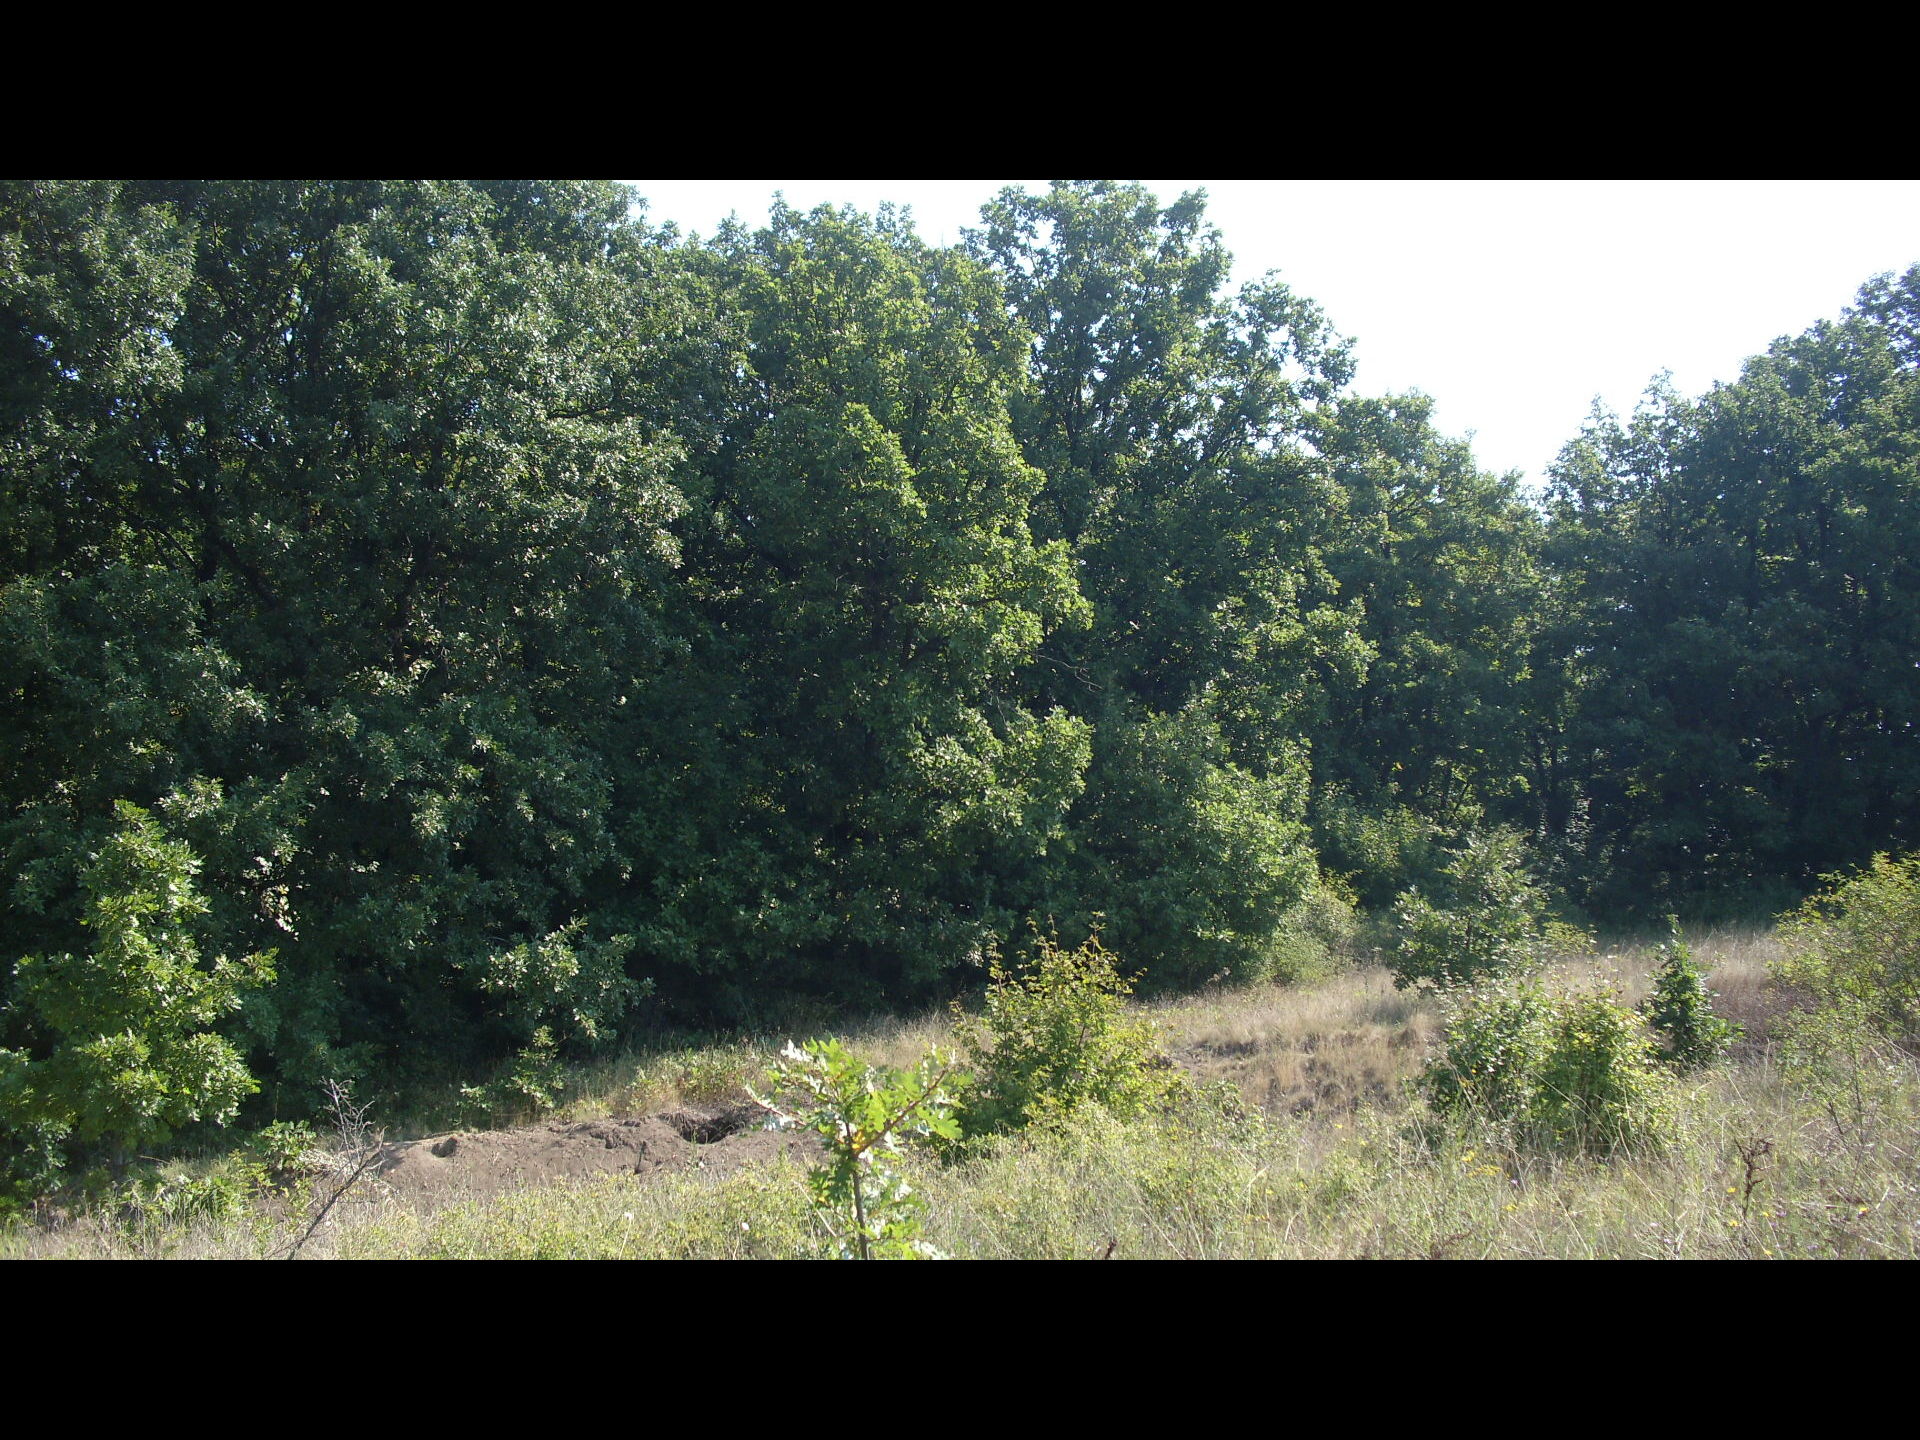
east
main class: Grassland
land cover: Grassland with sparse tree/shrub cover
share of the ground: > 75 %
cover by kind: herbaceous plants 85 %, shrubs 10 %, broadleaved forest trees 5 %
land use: Semi-natural and natural areas not in use
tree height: < 5 m
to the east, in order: Grassland with sparse tree/shrub cover; Ditches and canals; Grassland with sparse tree/shrub cover; Broadleaved woodland; Tracks; Grass margins; Other bare soil
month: September
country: BG
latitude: 44.0409
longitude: 22.5524
